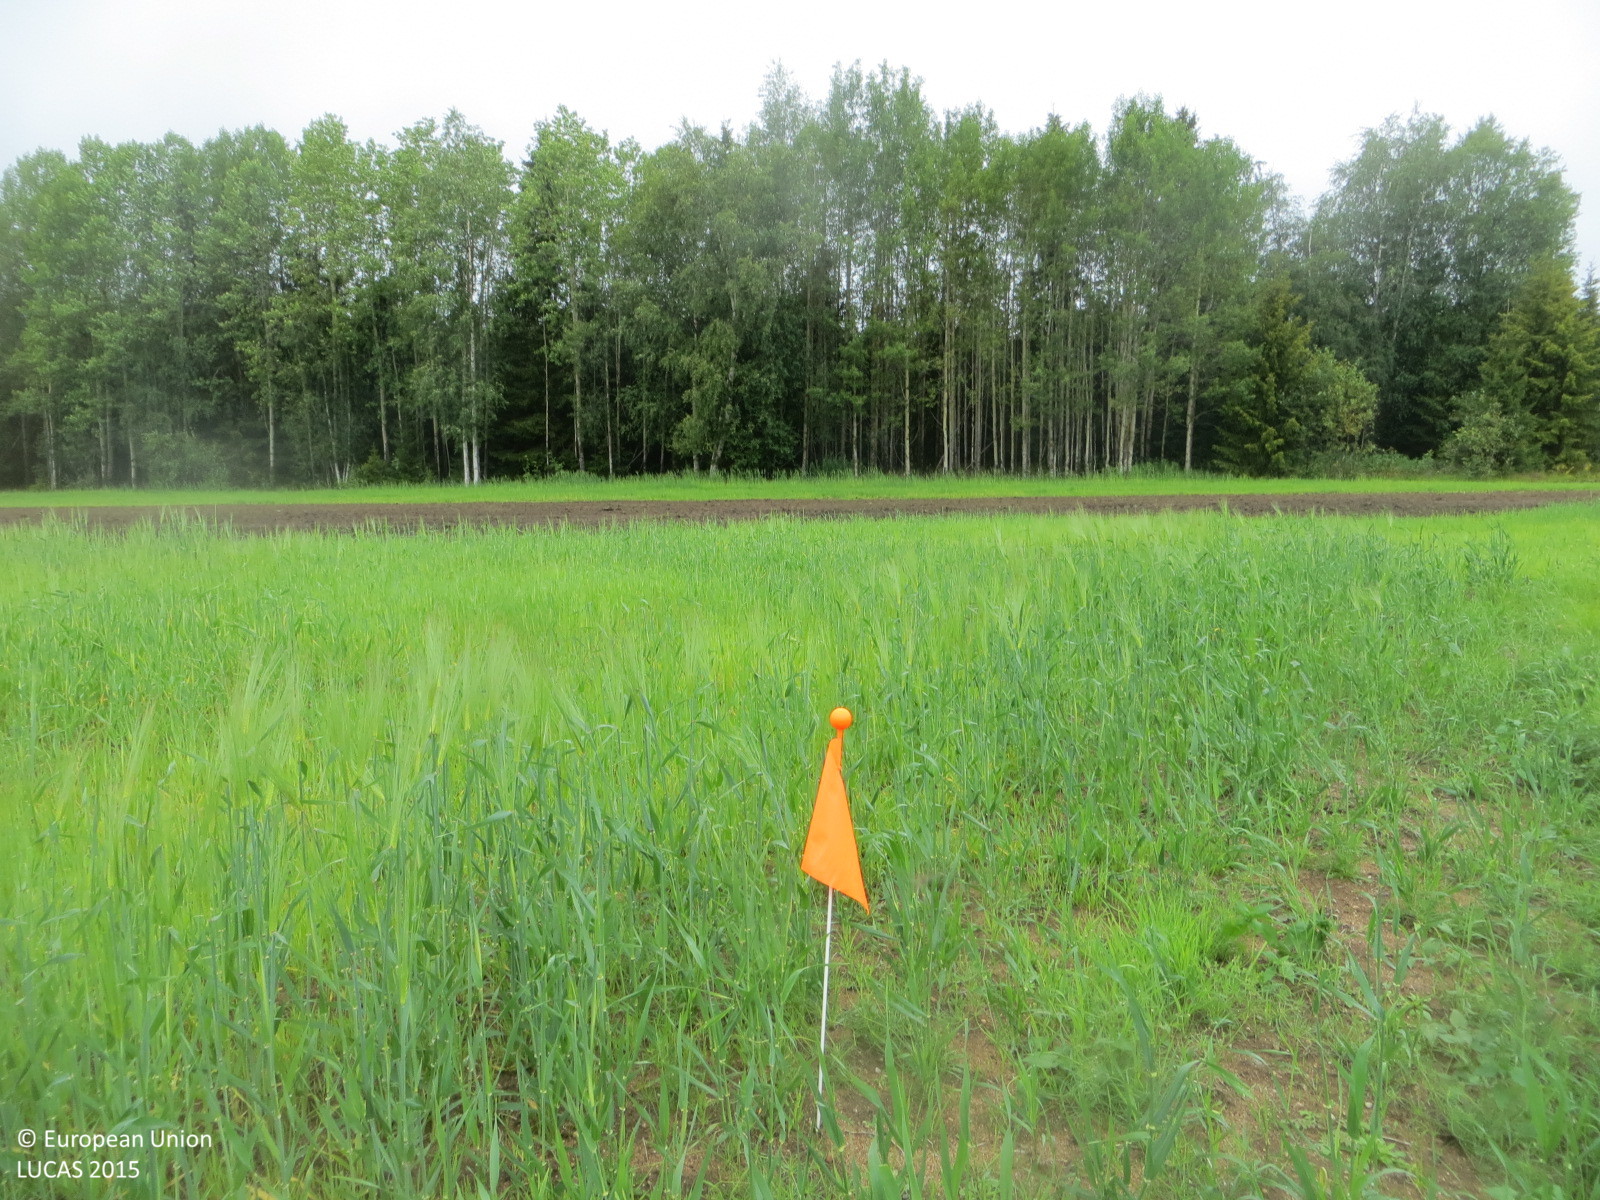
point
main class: Cropland
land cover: Barley
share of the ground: > 75 %
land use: Agriculture (excluding fallow land and kitchen gardens)
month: July
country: FI
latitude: 65.8248
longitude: 24.5632
